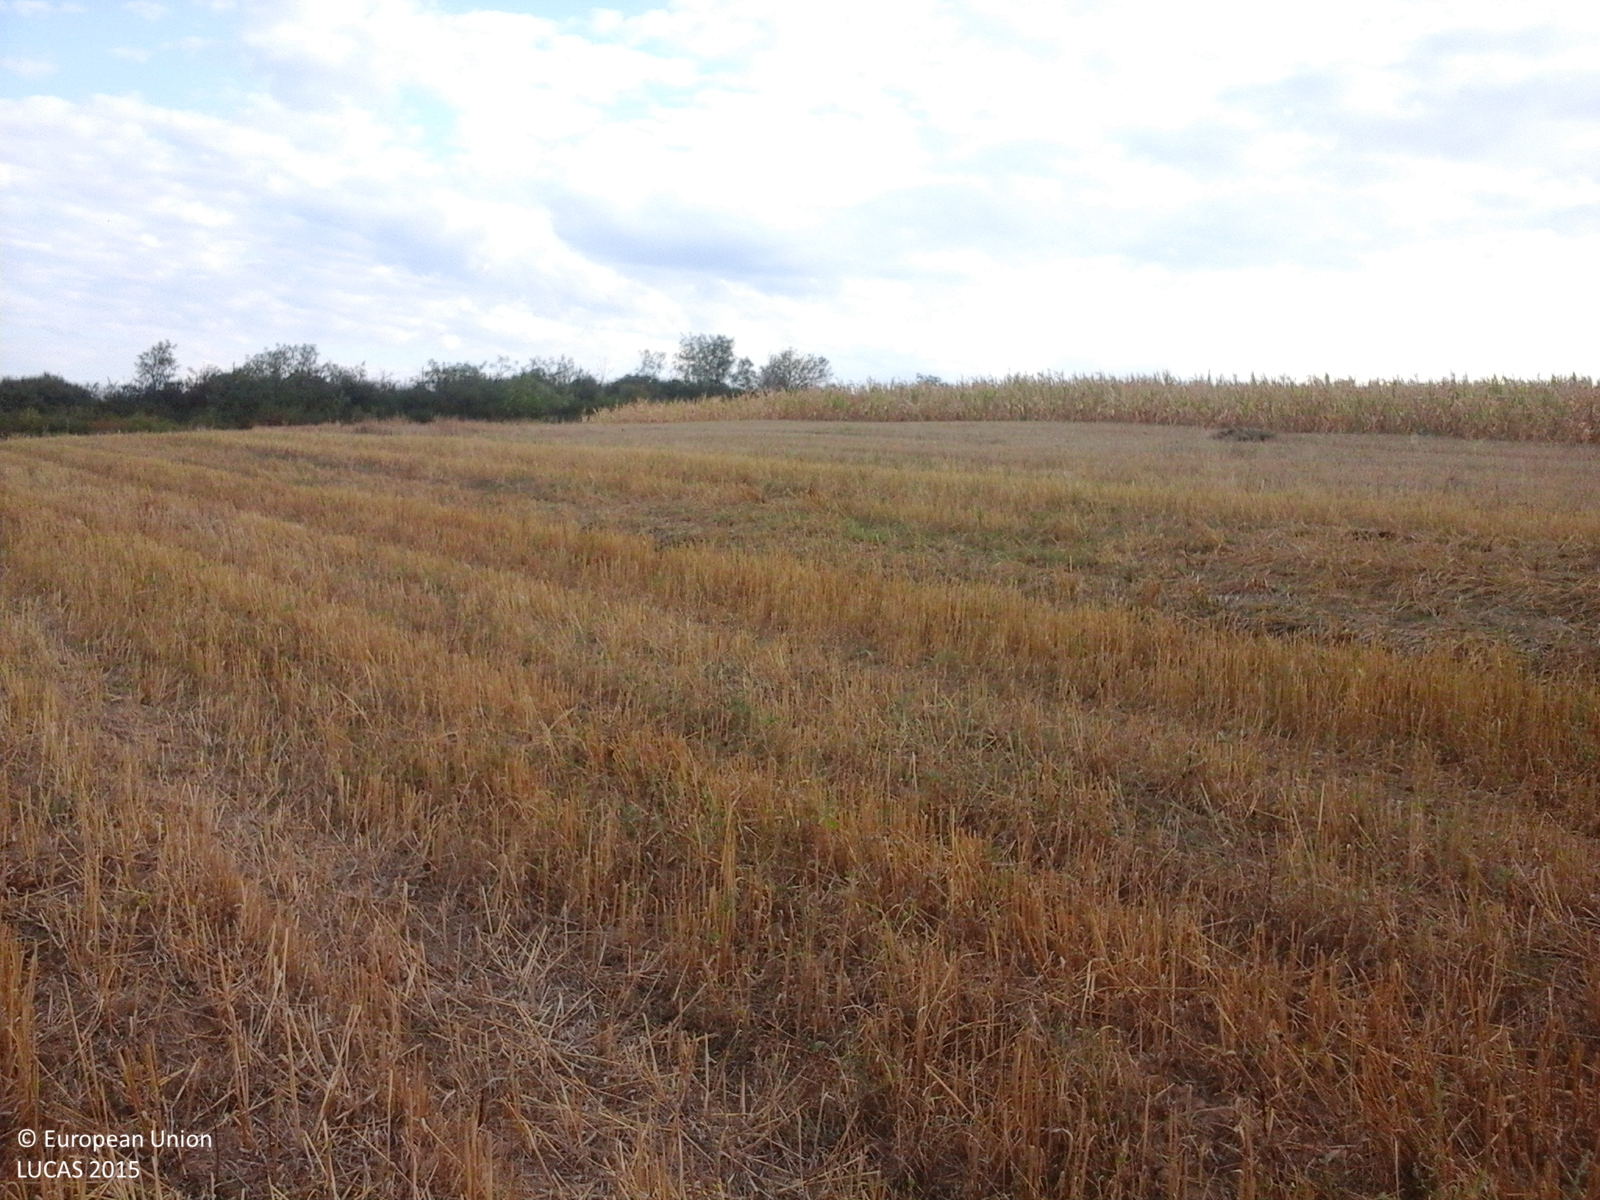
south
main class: Cropland
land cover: Oats
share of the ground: 50 - 75 %
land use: Agriculture (excluding fallow land and kitchen gardens)
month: September
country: RO
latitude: 47.6043
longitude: 22.9270
